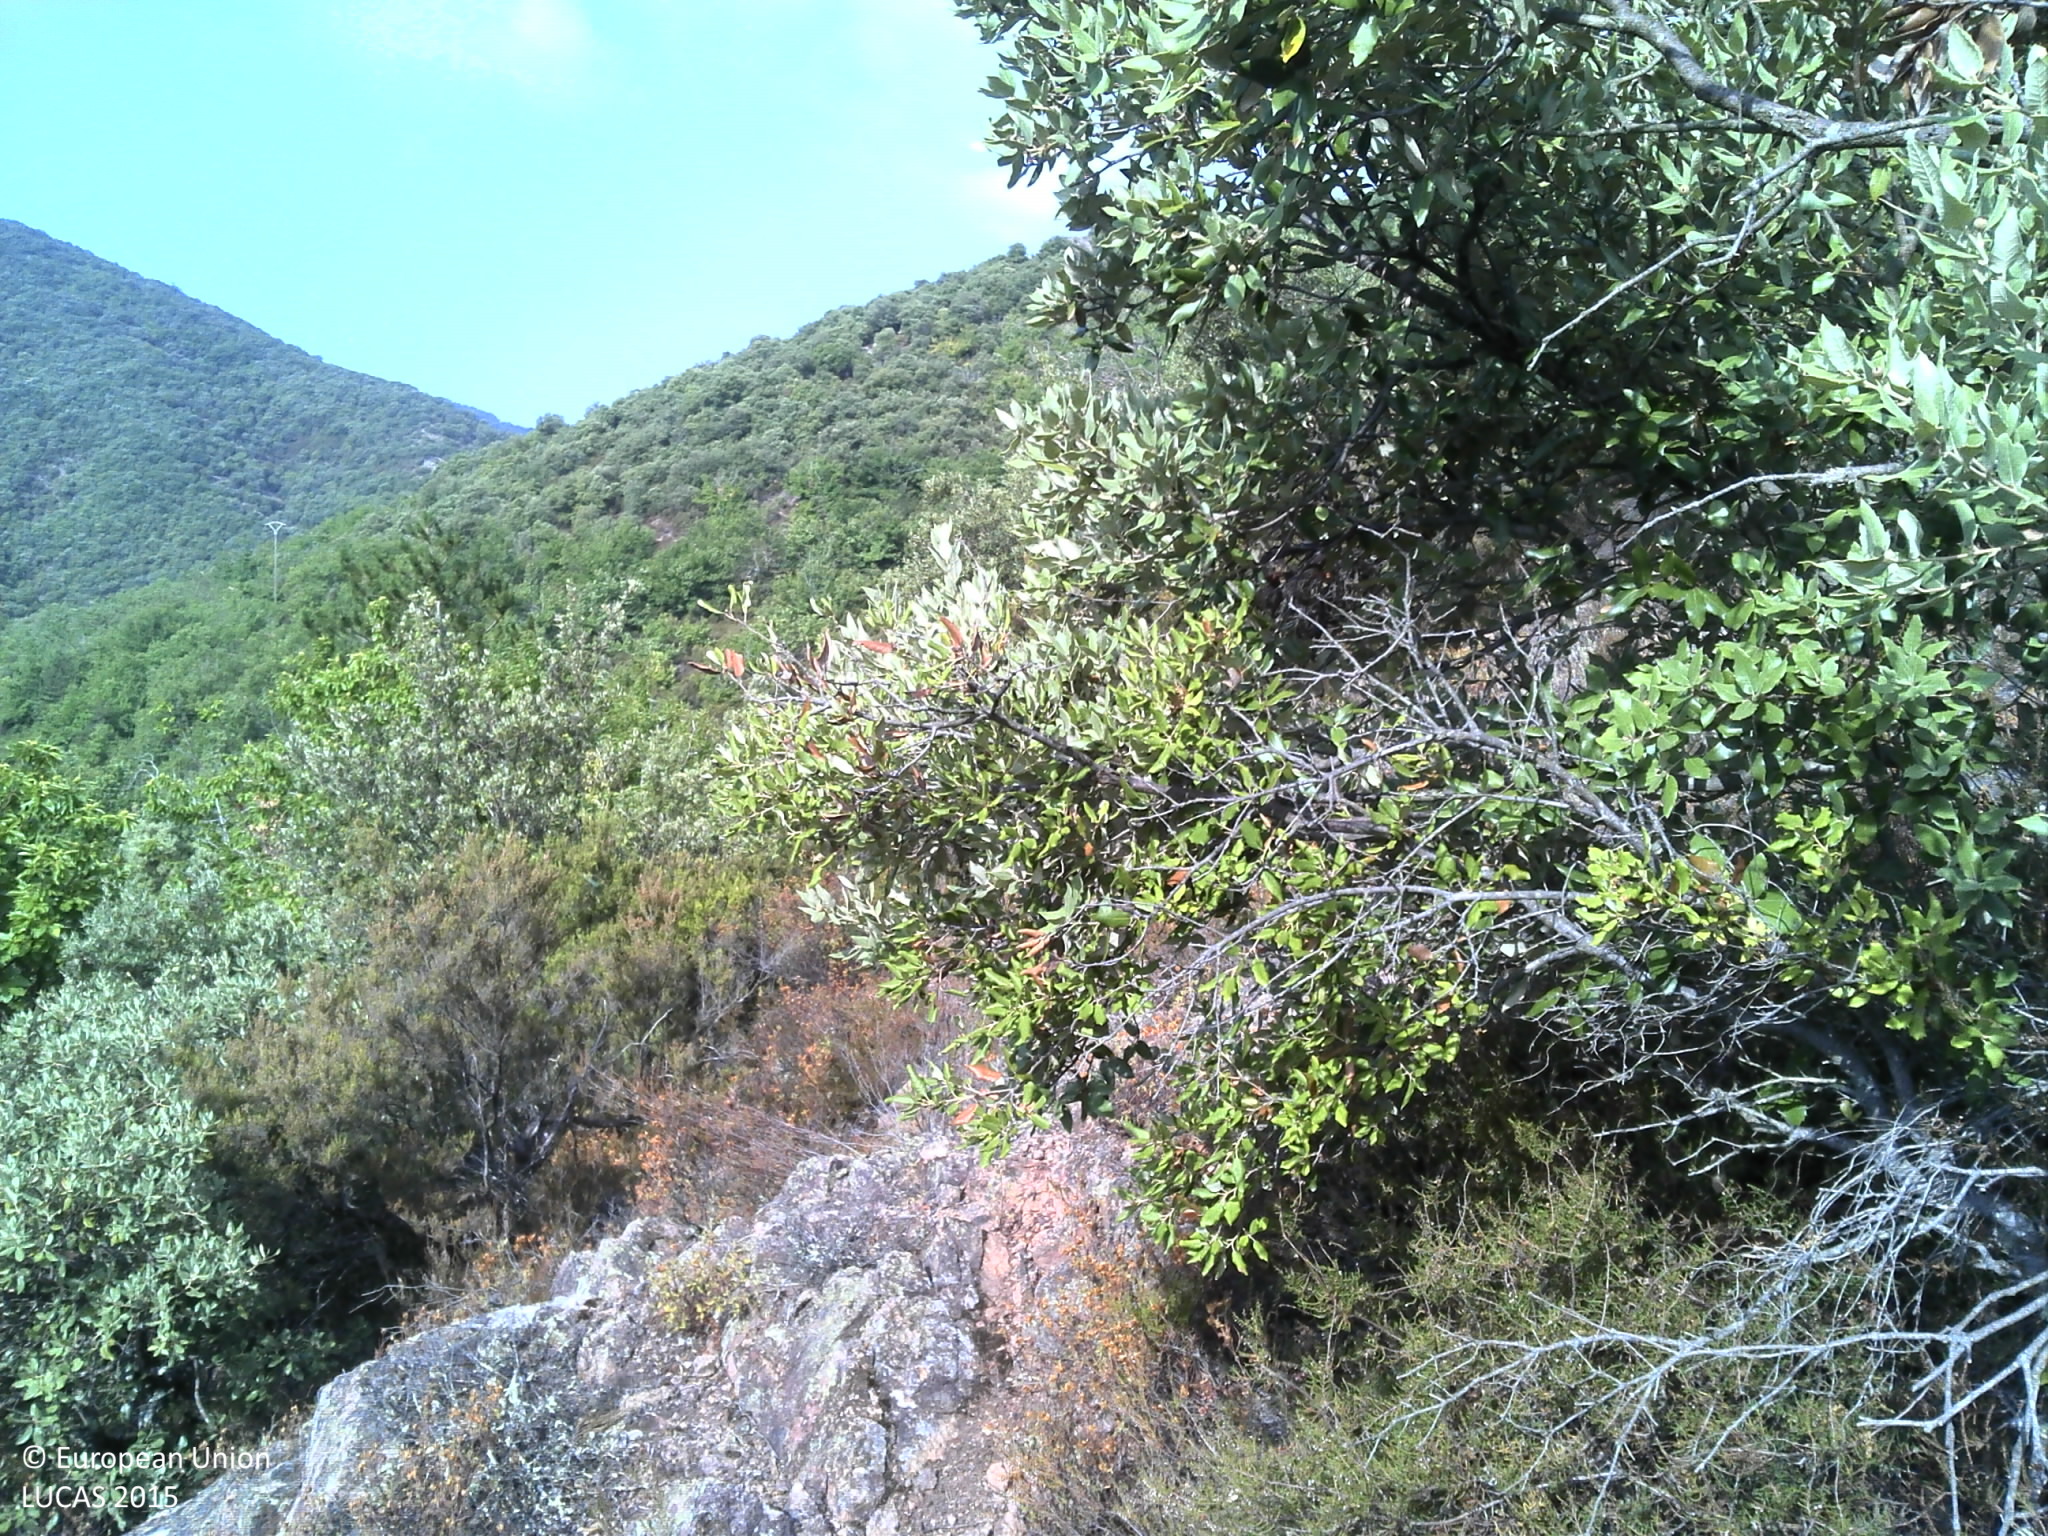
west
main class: Shrubland
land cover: Shrubland with sparse tree cover
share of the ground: > 75 %
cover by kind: shrubs 70 %, consolidated bare surface 25 %, broadleaved forest trees 5 %
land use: Semi-natural and natural areas not in use
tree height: < 5 m
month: July
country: FR
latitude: 43.7254
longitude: 3.1428
